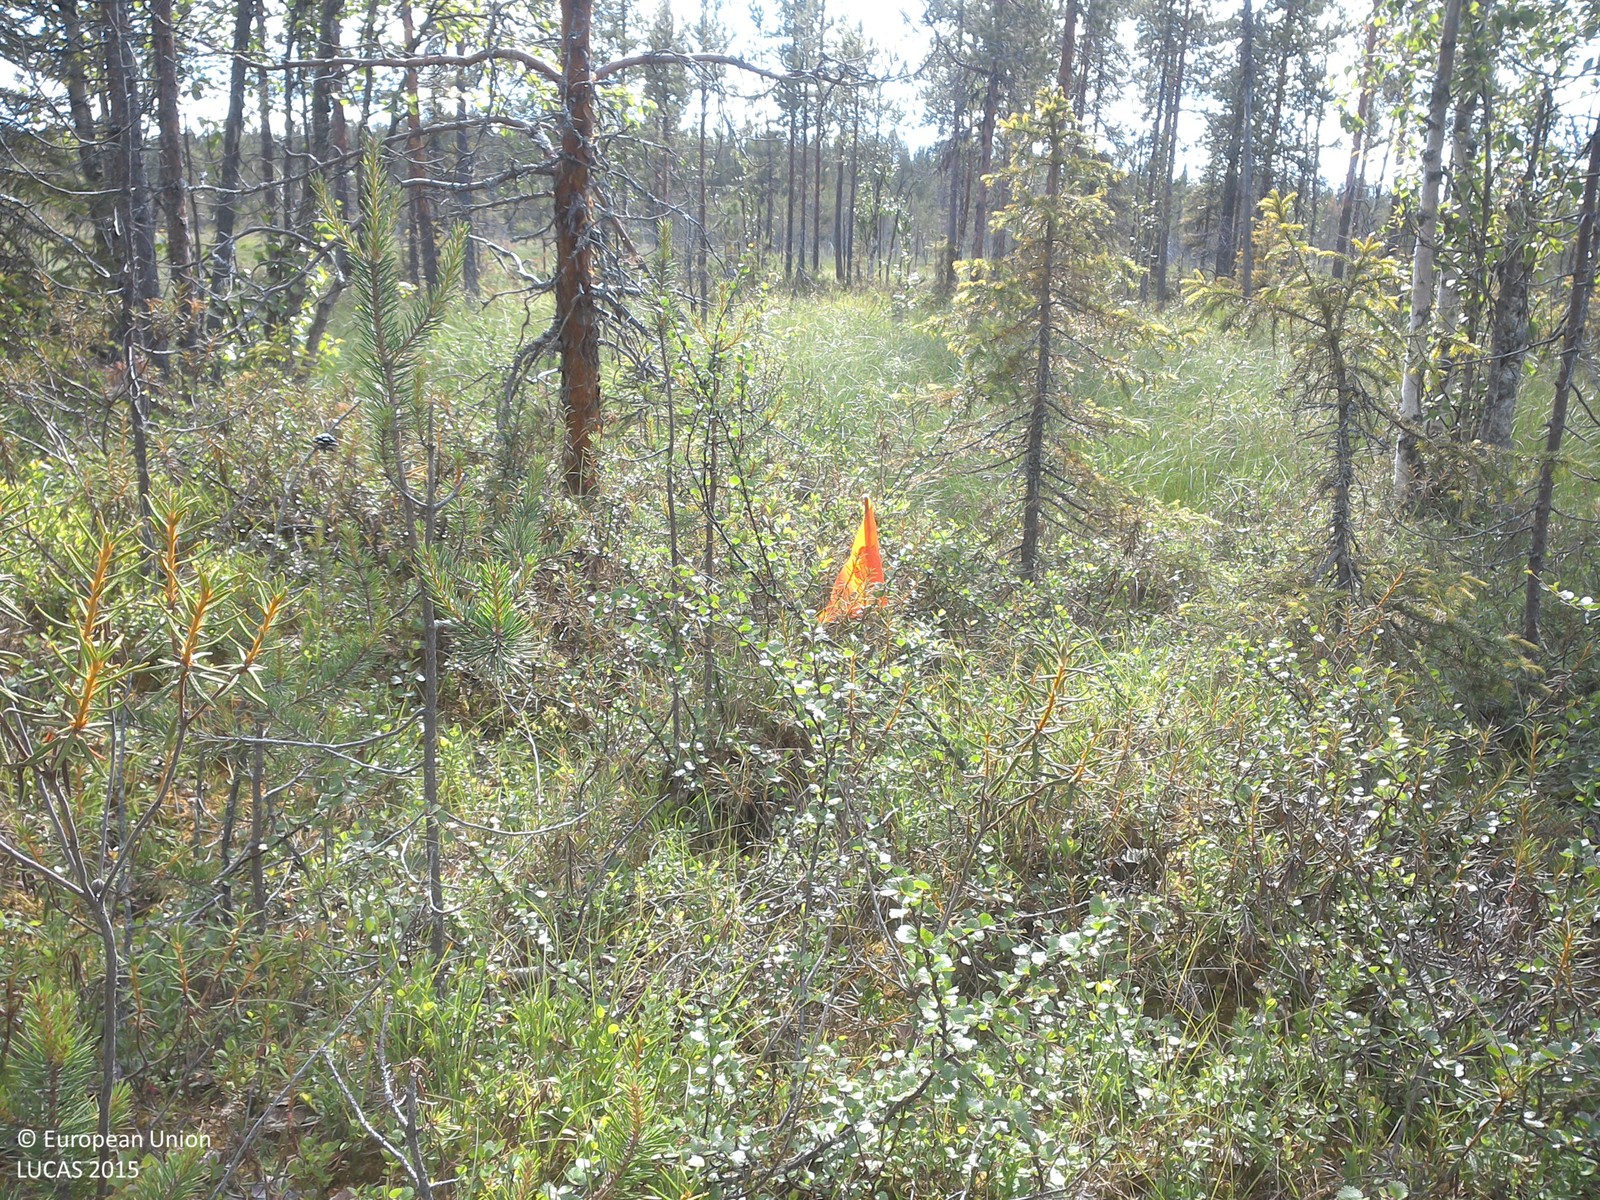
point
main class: Woodland
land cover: Pine dominated mixed woodland
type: boreal forest
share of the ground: 25 - 50 %
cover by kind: herbaceous plants 35 %, shrubs 30 %, coniferous forest trees 20 %, broadleaved forest trees 10 %, lichens and mosses 5 %
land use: Forestry
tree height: > 5 m
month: July
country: SE
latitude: 67.4386
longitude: 23.3512
